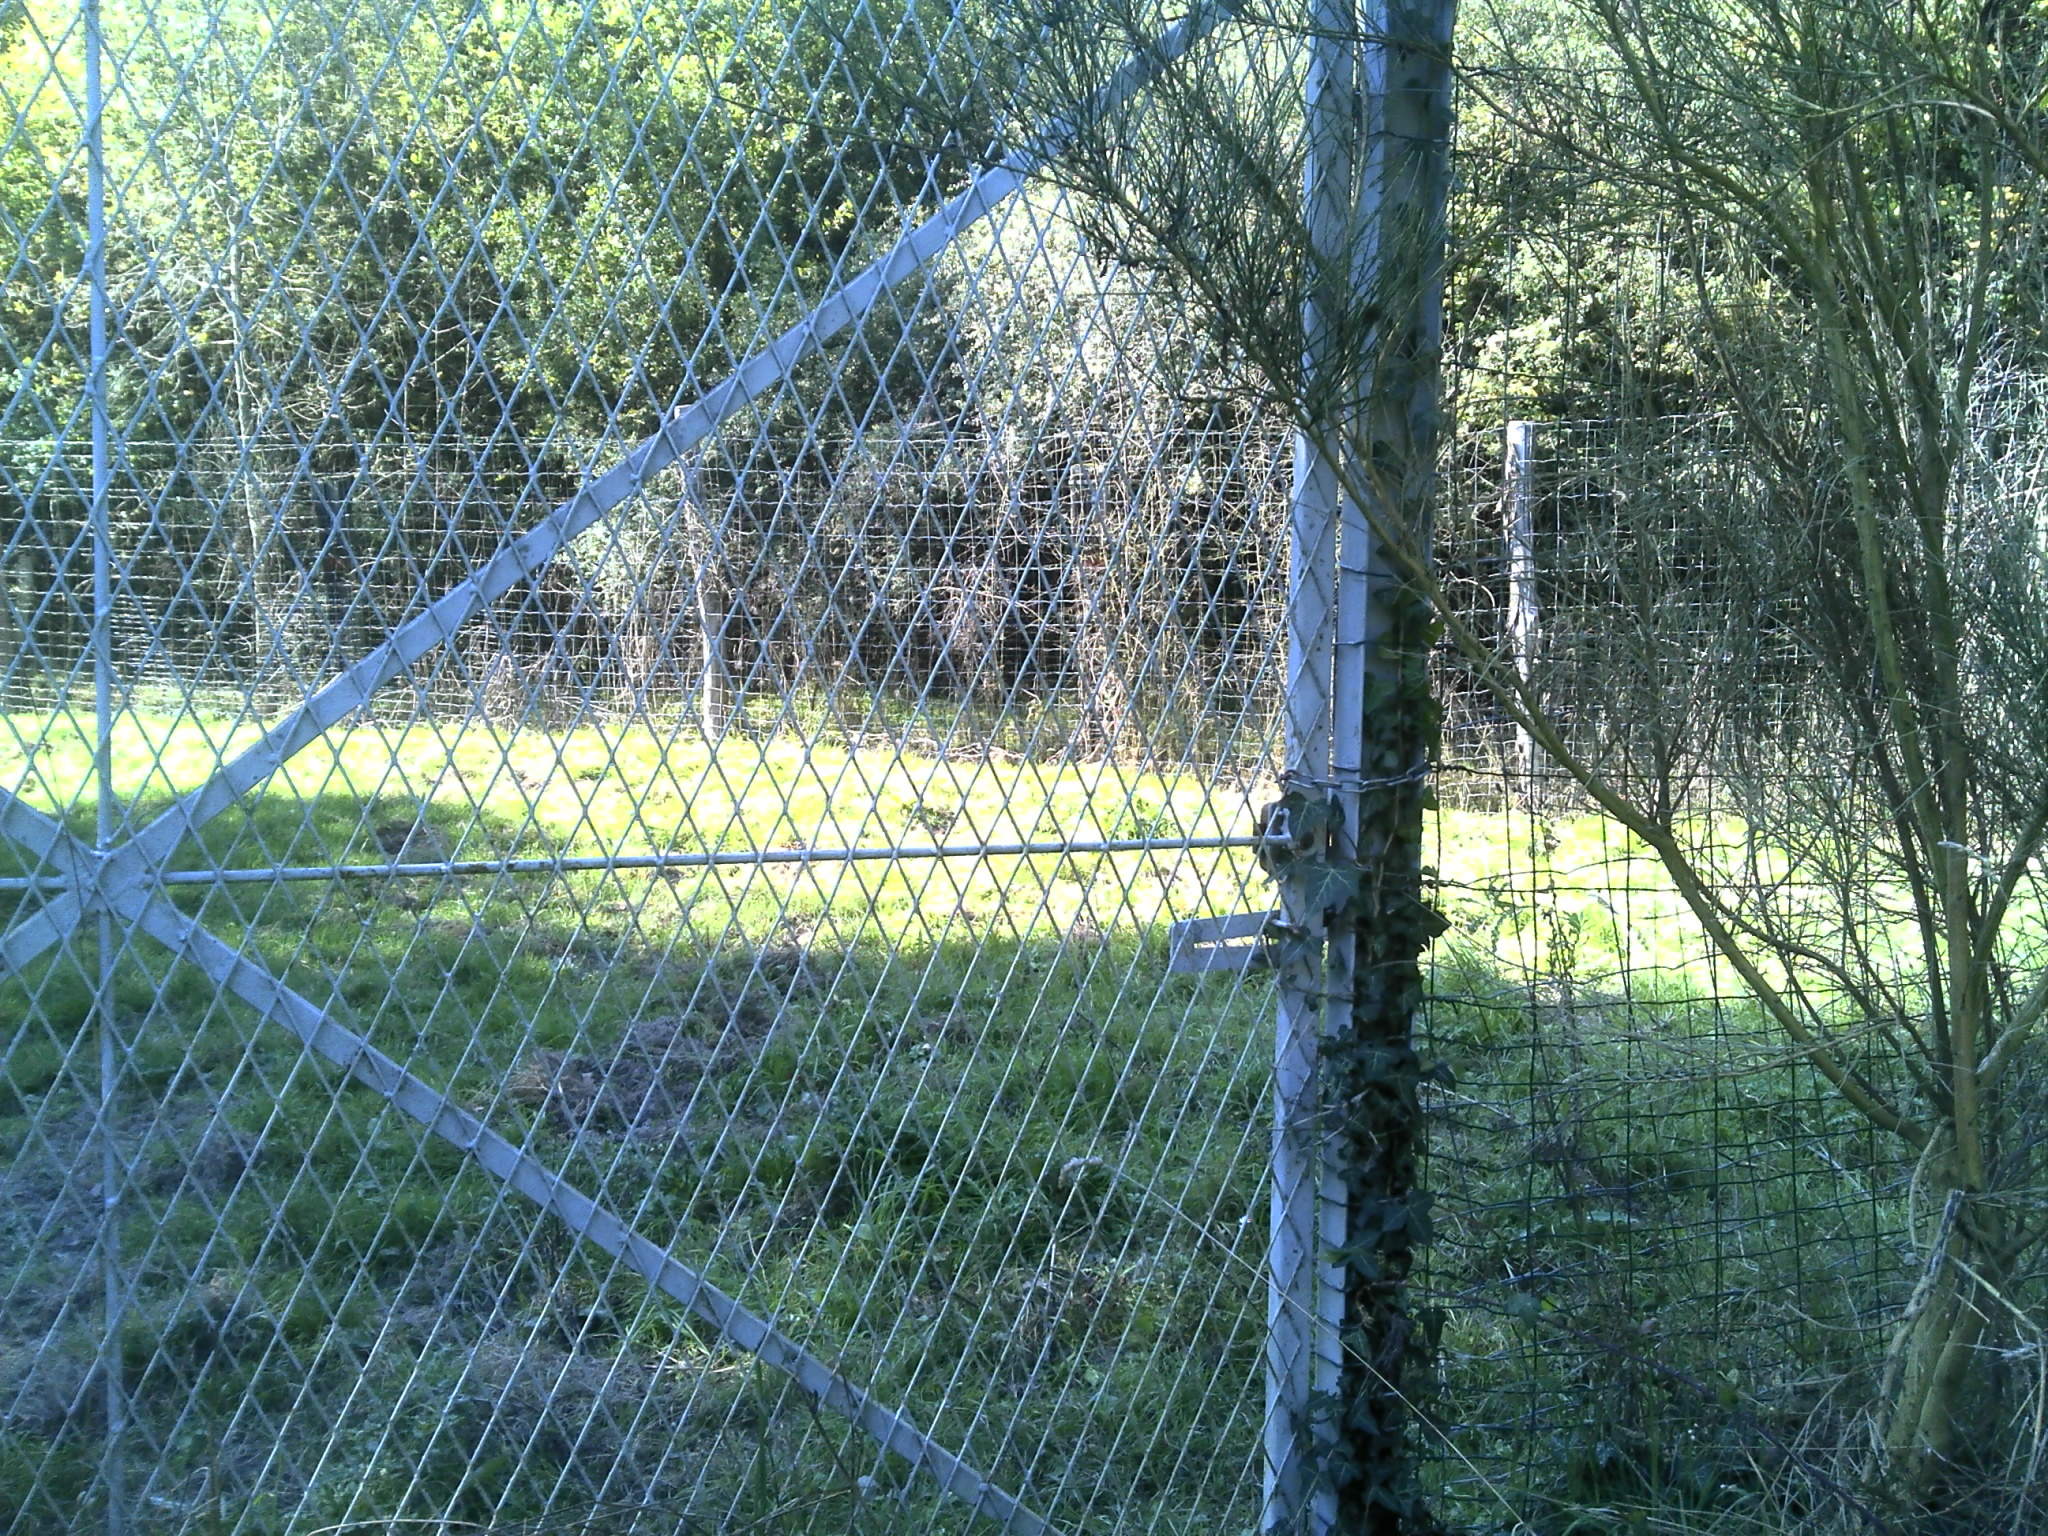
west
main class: Woodland
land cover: Broadleaved woodland
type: mesophytic deciduous forest
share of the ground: > 75 %
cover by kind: broadleaved forest trees 90 %, herbaceous plants 10 %
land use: Forestry
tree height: > 5 m
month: October
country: FR
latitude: 47.5061
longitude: -1.0167
